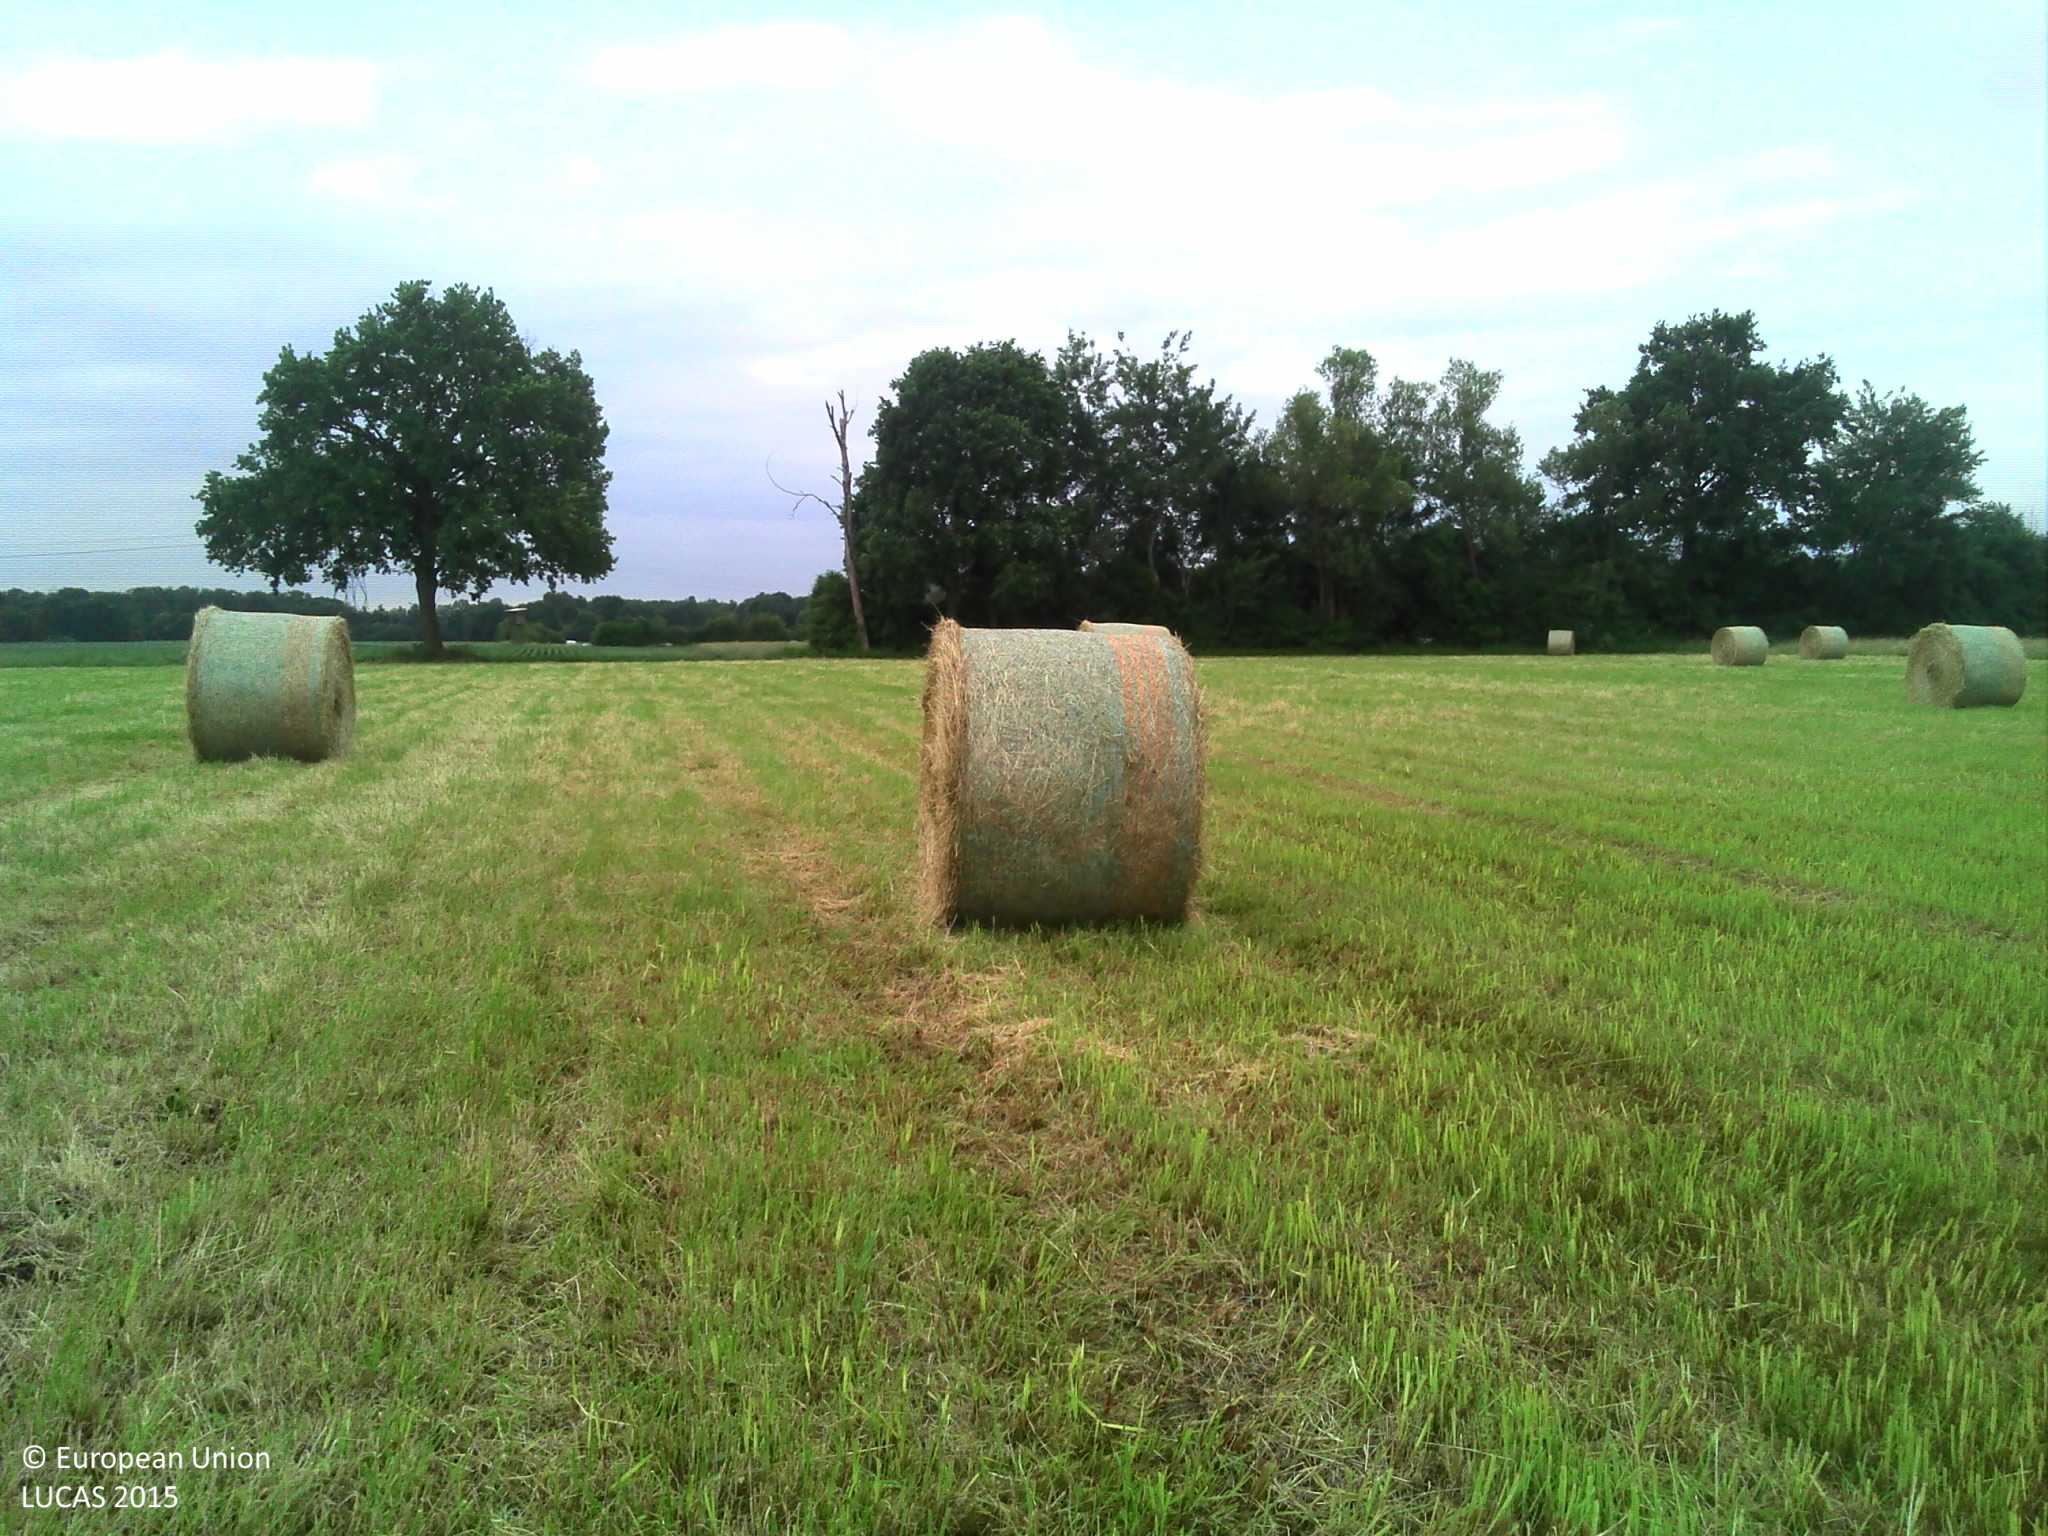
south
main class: Grassland
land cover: Grassland without tree/shrub cover
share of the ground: > 75 %
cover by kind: herbaceous plants 100 %
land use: Agriculture (excluding fallow land and kitchen gardens)
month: June
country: FR
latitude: 48.4856
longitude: 7.6061
